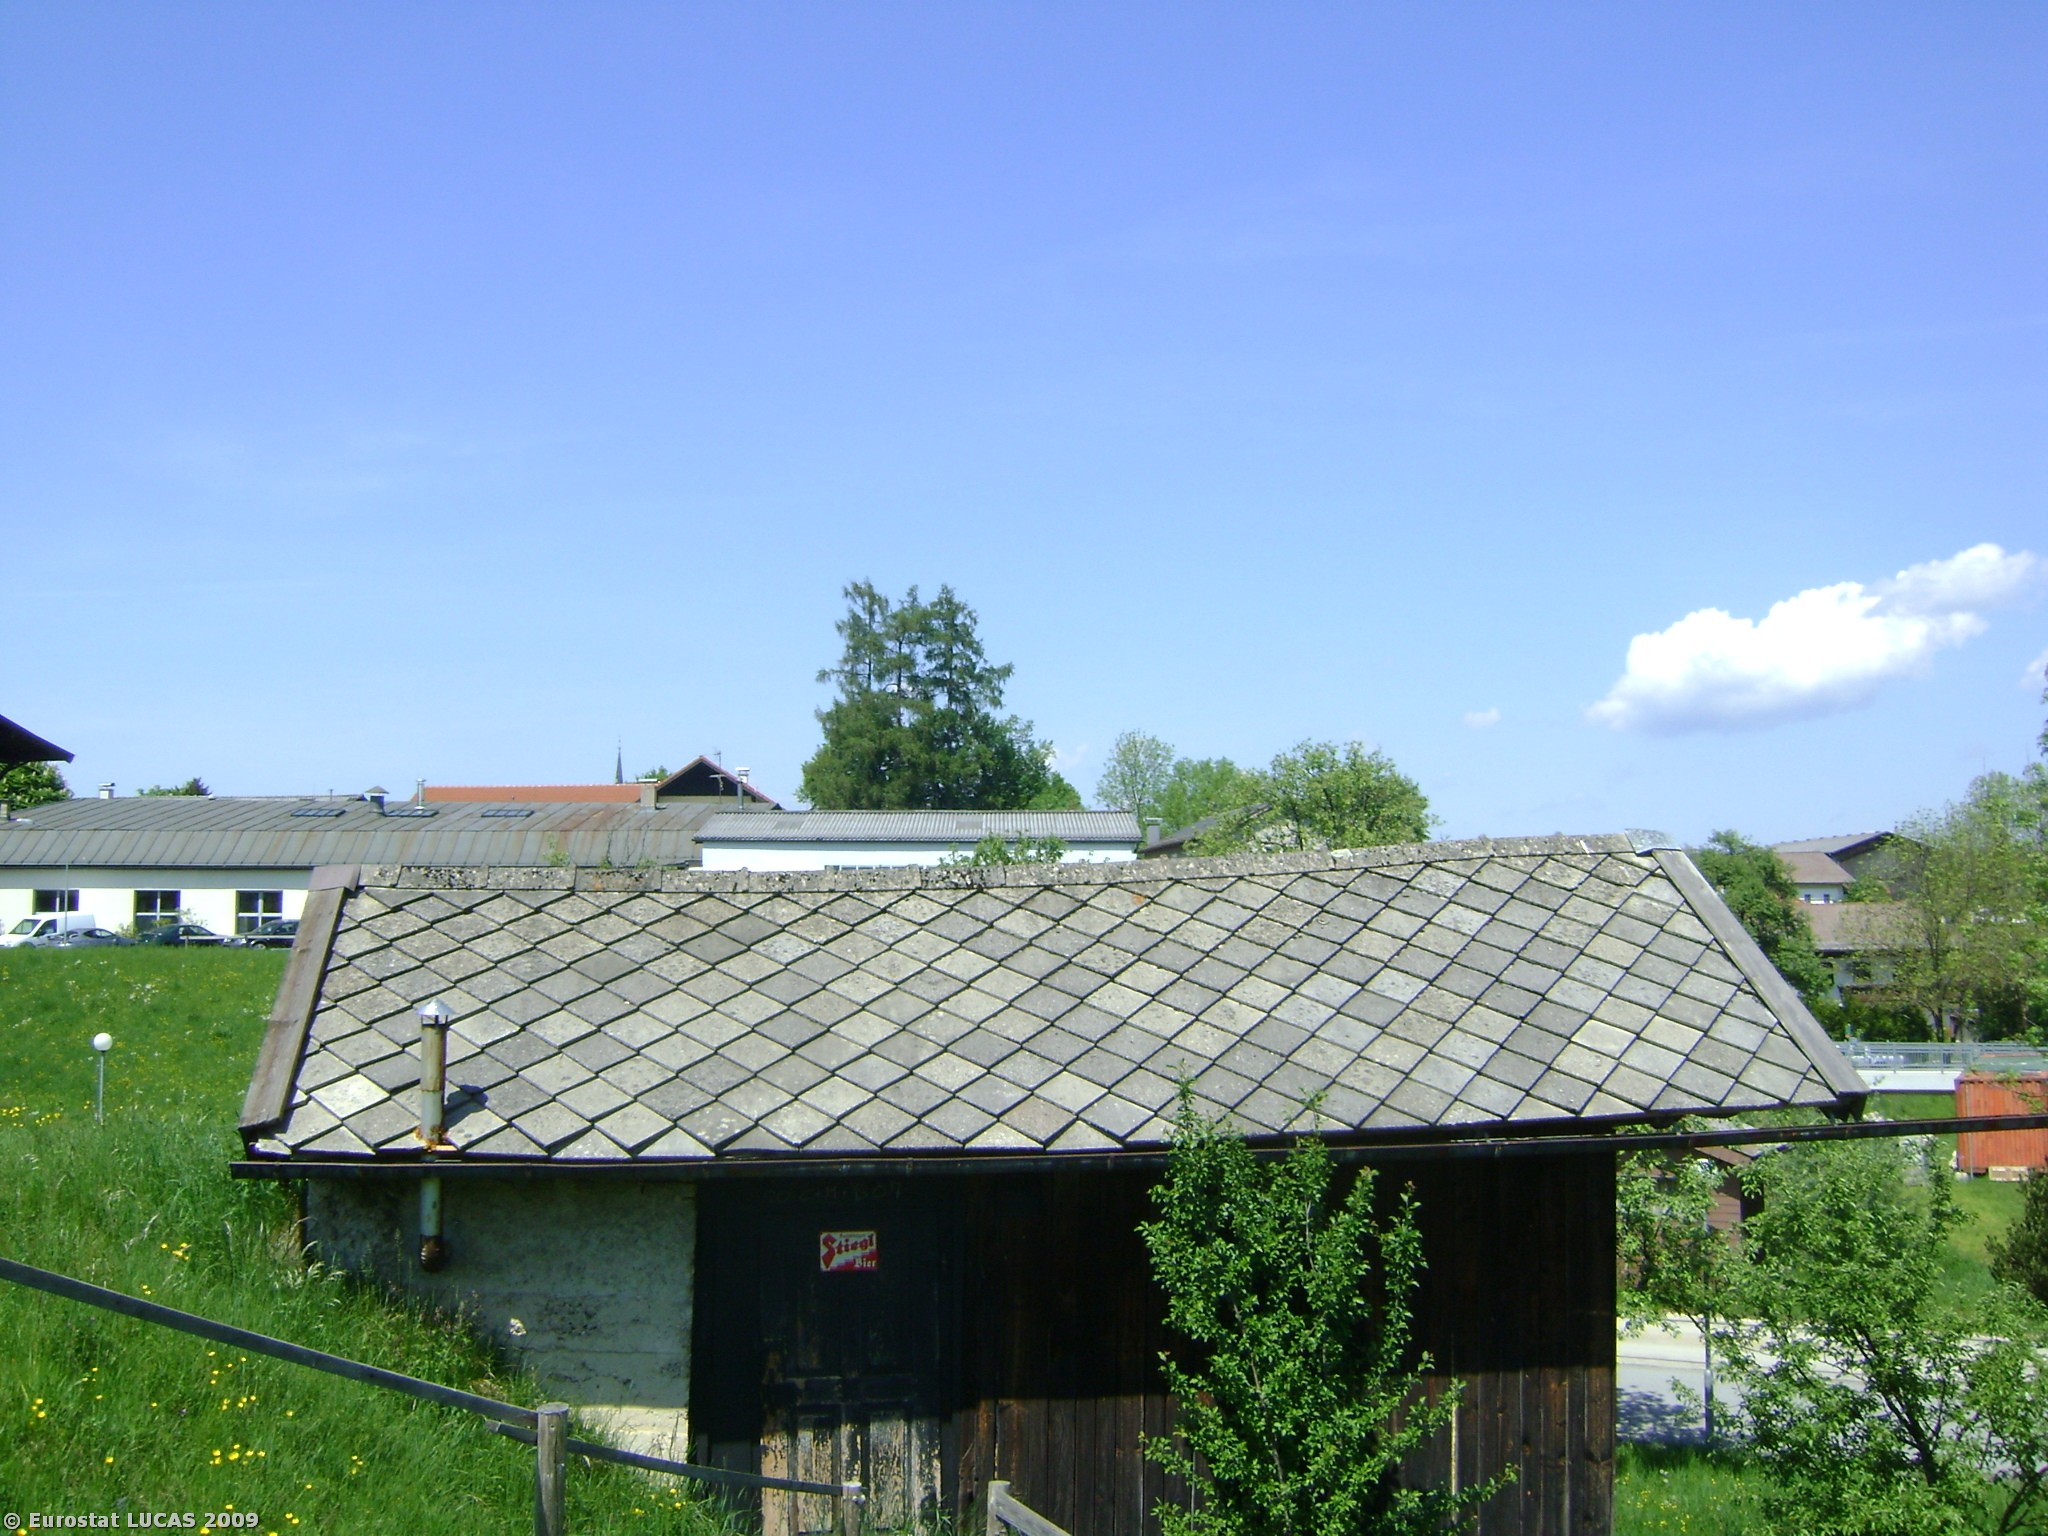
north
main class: Grassland
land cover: Grassland with sparse tree/shrub cover
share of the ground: > 75 %
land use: Agriculture (excluding fallow land and kitchen gardens)
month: May
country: AT
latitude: 47.9423
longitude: 13.2253
